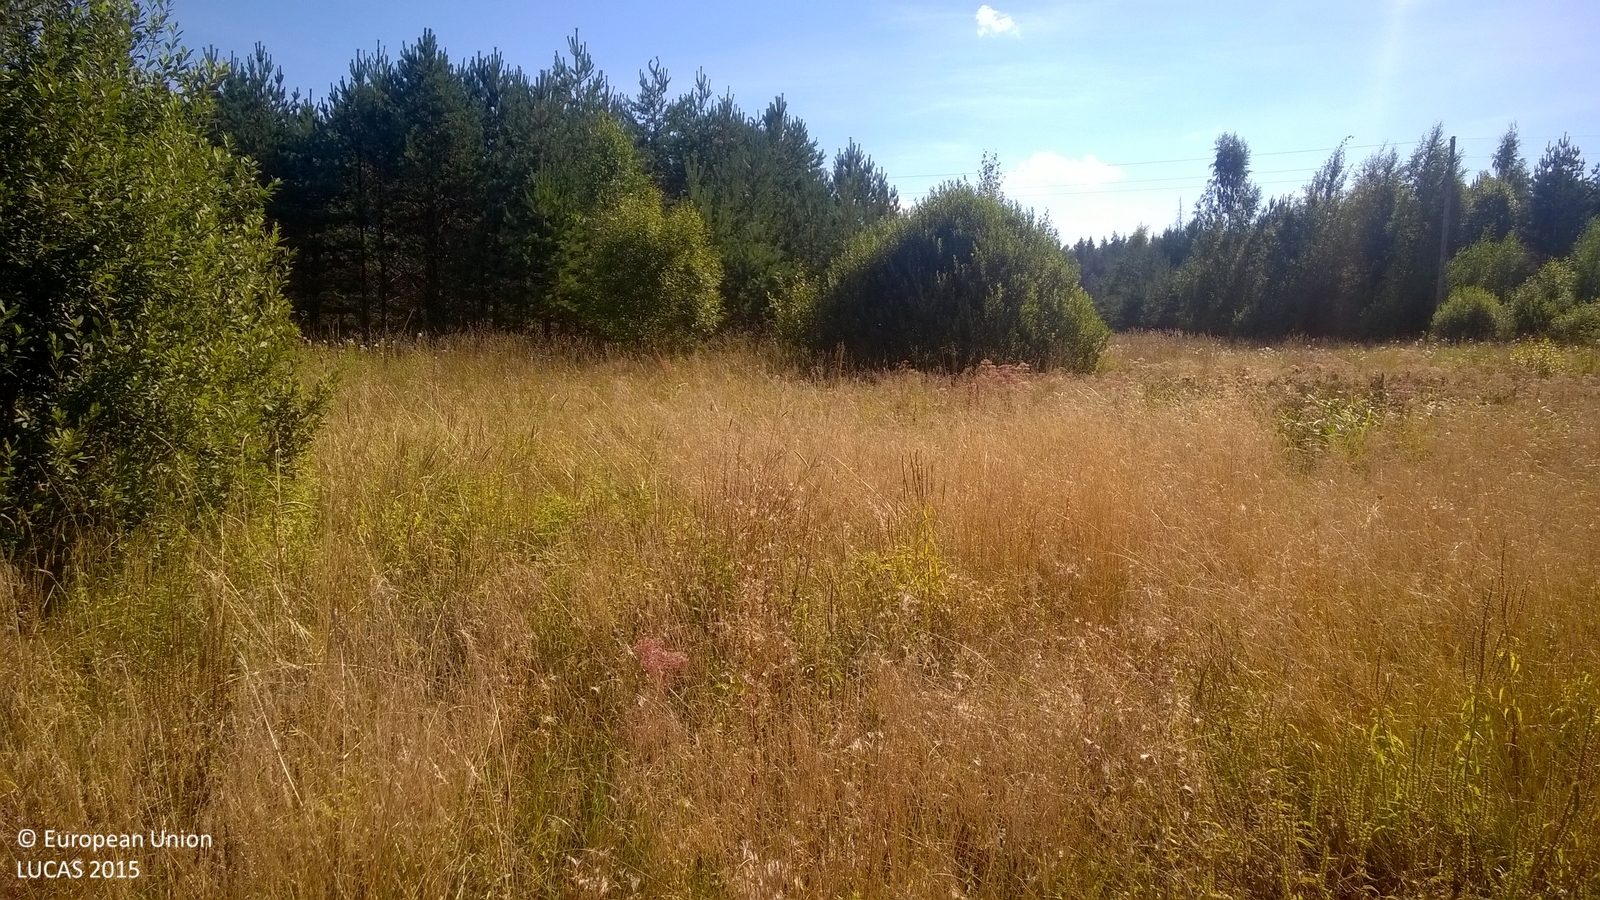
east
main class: Grassland
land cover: Spontaneously vegetated surfaces
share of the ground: > 75 %
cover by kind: herbaceous plants 95 %, shrubs 5 %
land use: Semi-natural and natural areas not in use
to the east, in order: Spontaneously vegetated surfaces; Pine dominated coniferous woodland; Electric lines; Grassland with sparse tree/shrub cover
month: August
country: LV
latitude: 57.7141
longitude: 26.1273
